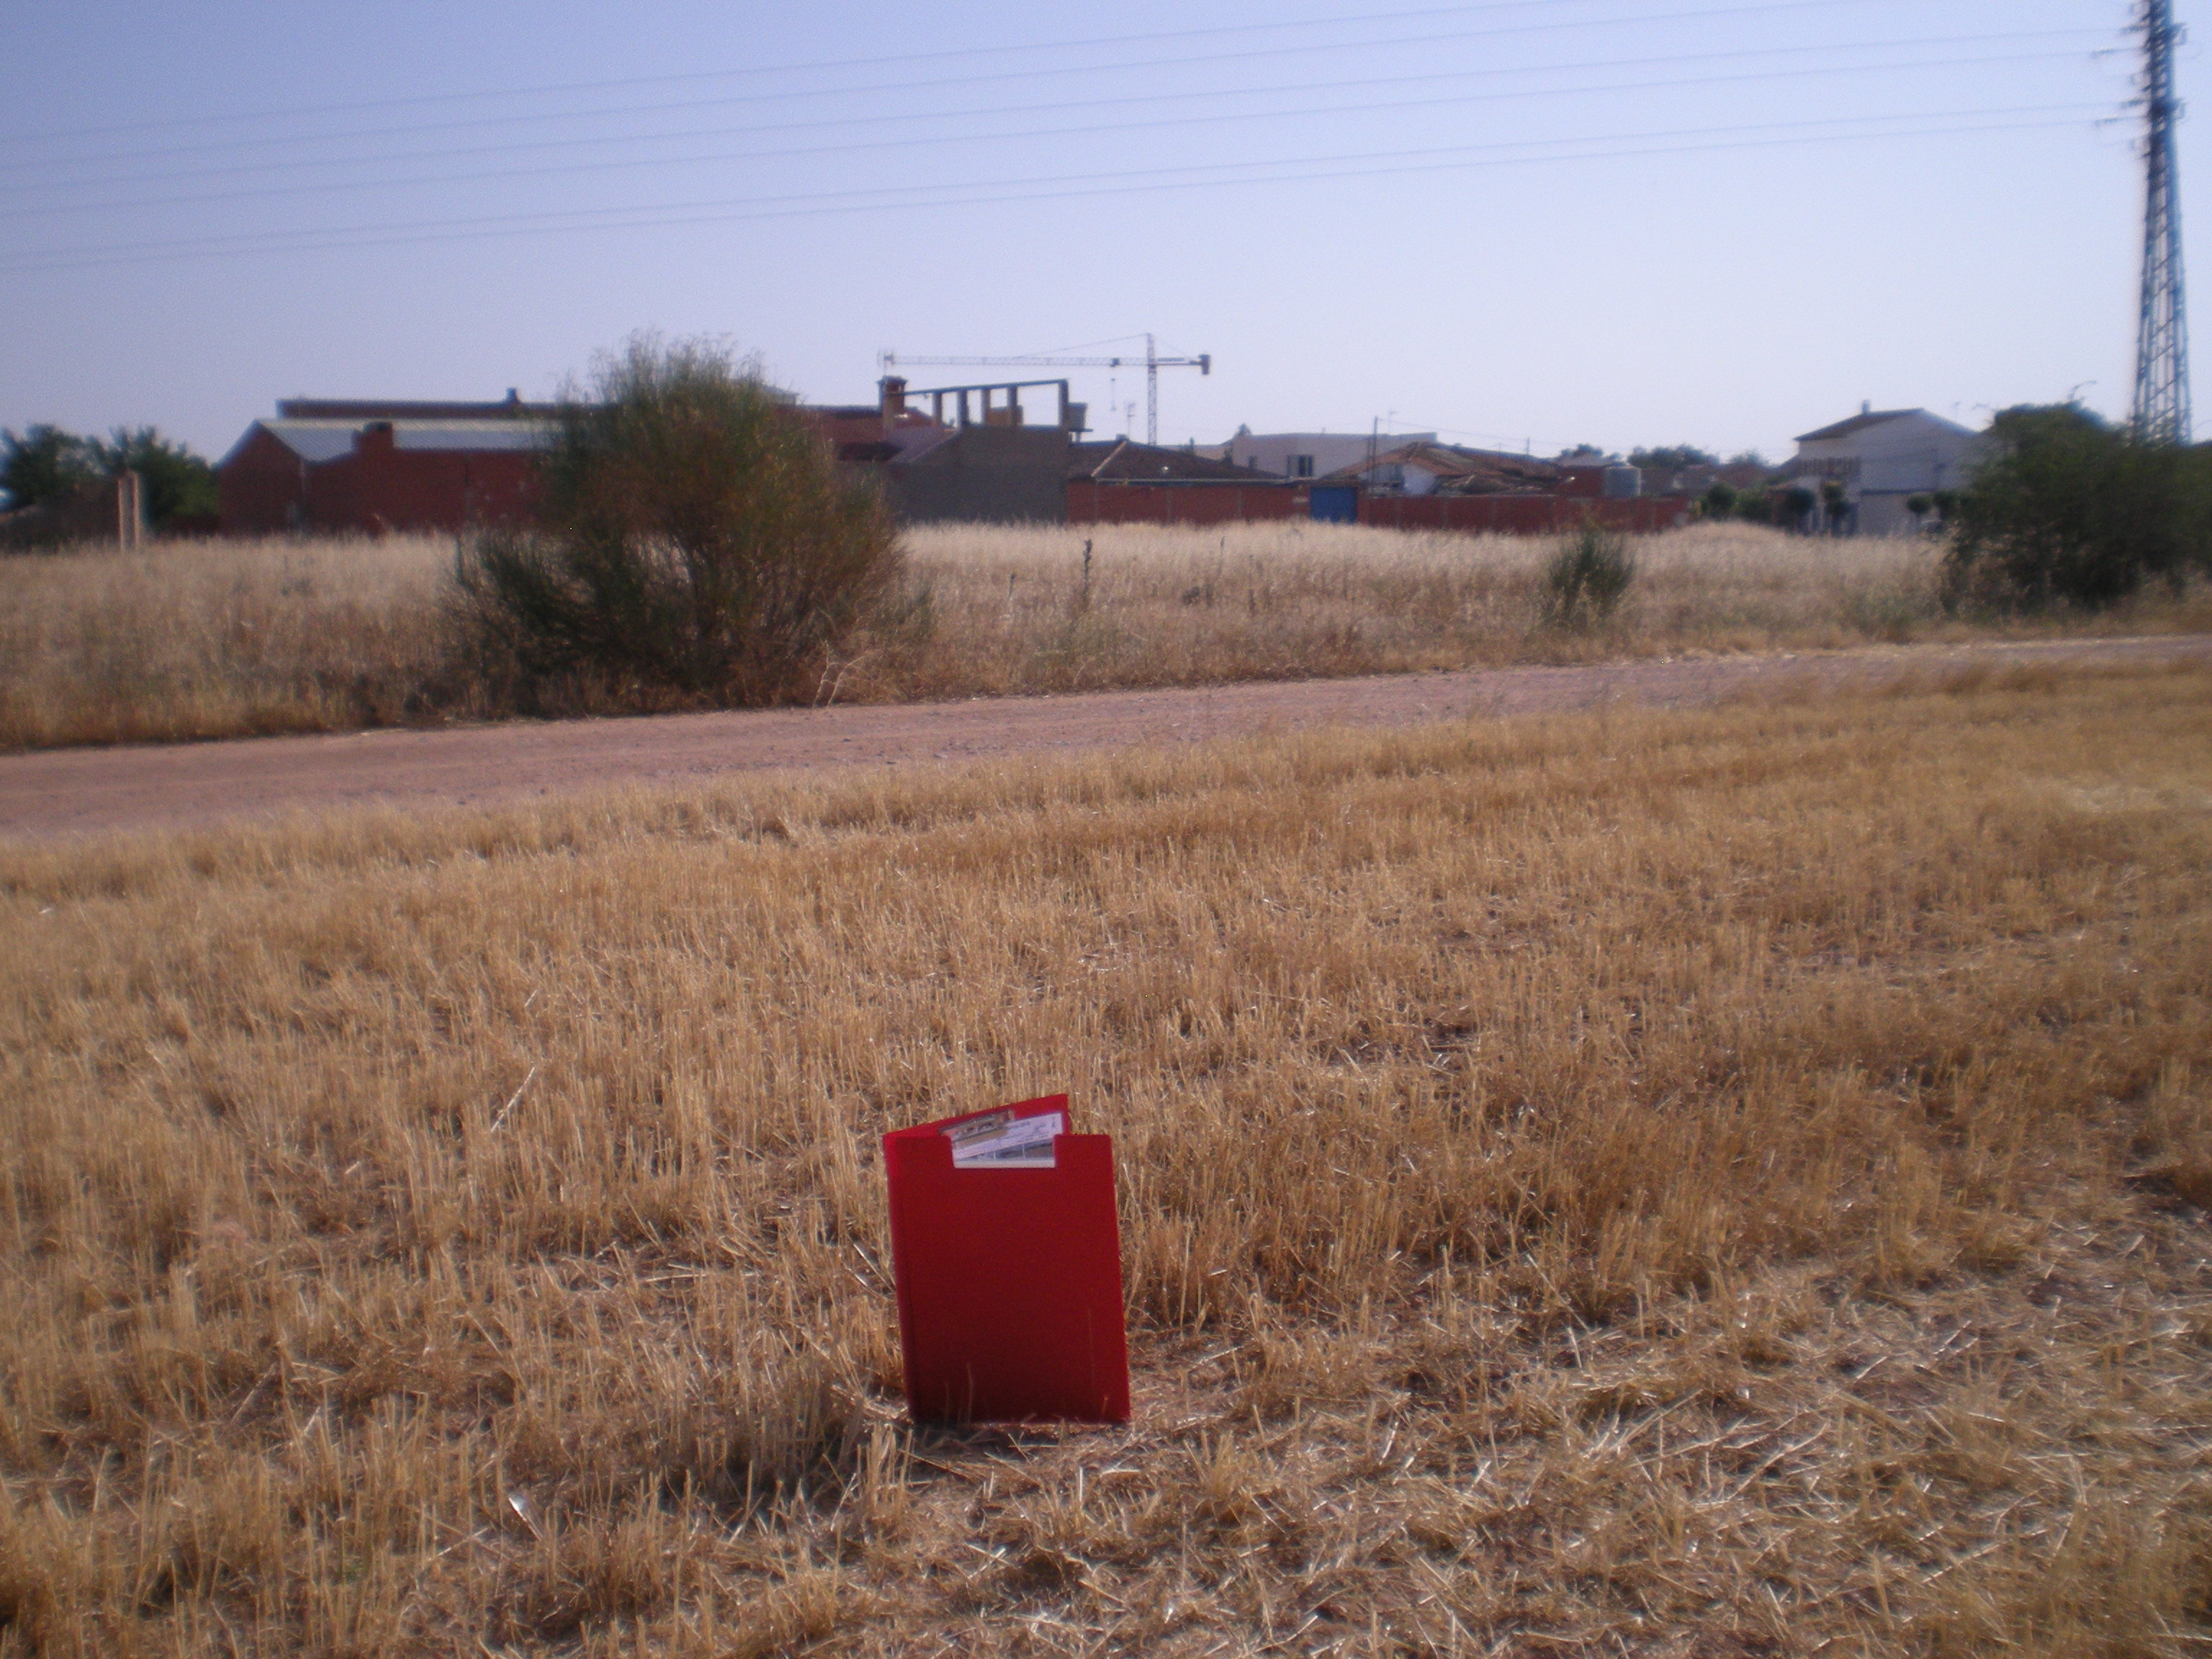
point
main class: Cropland
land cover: Barley
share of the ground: < 10 %
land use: Agriculture (excluding fallow land and kitchen gardens)
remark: Harvested field
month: July
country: ES
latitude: 39.4214
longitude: -3.3667
